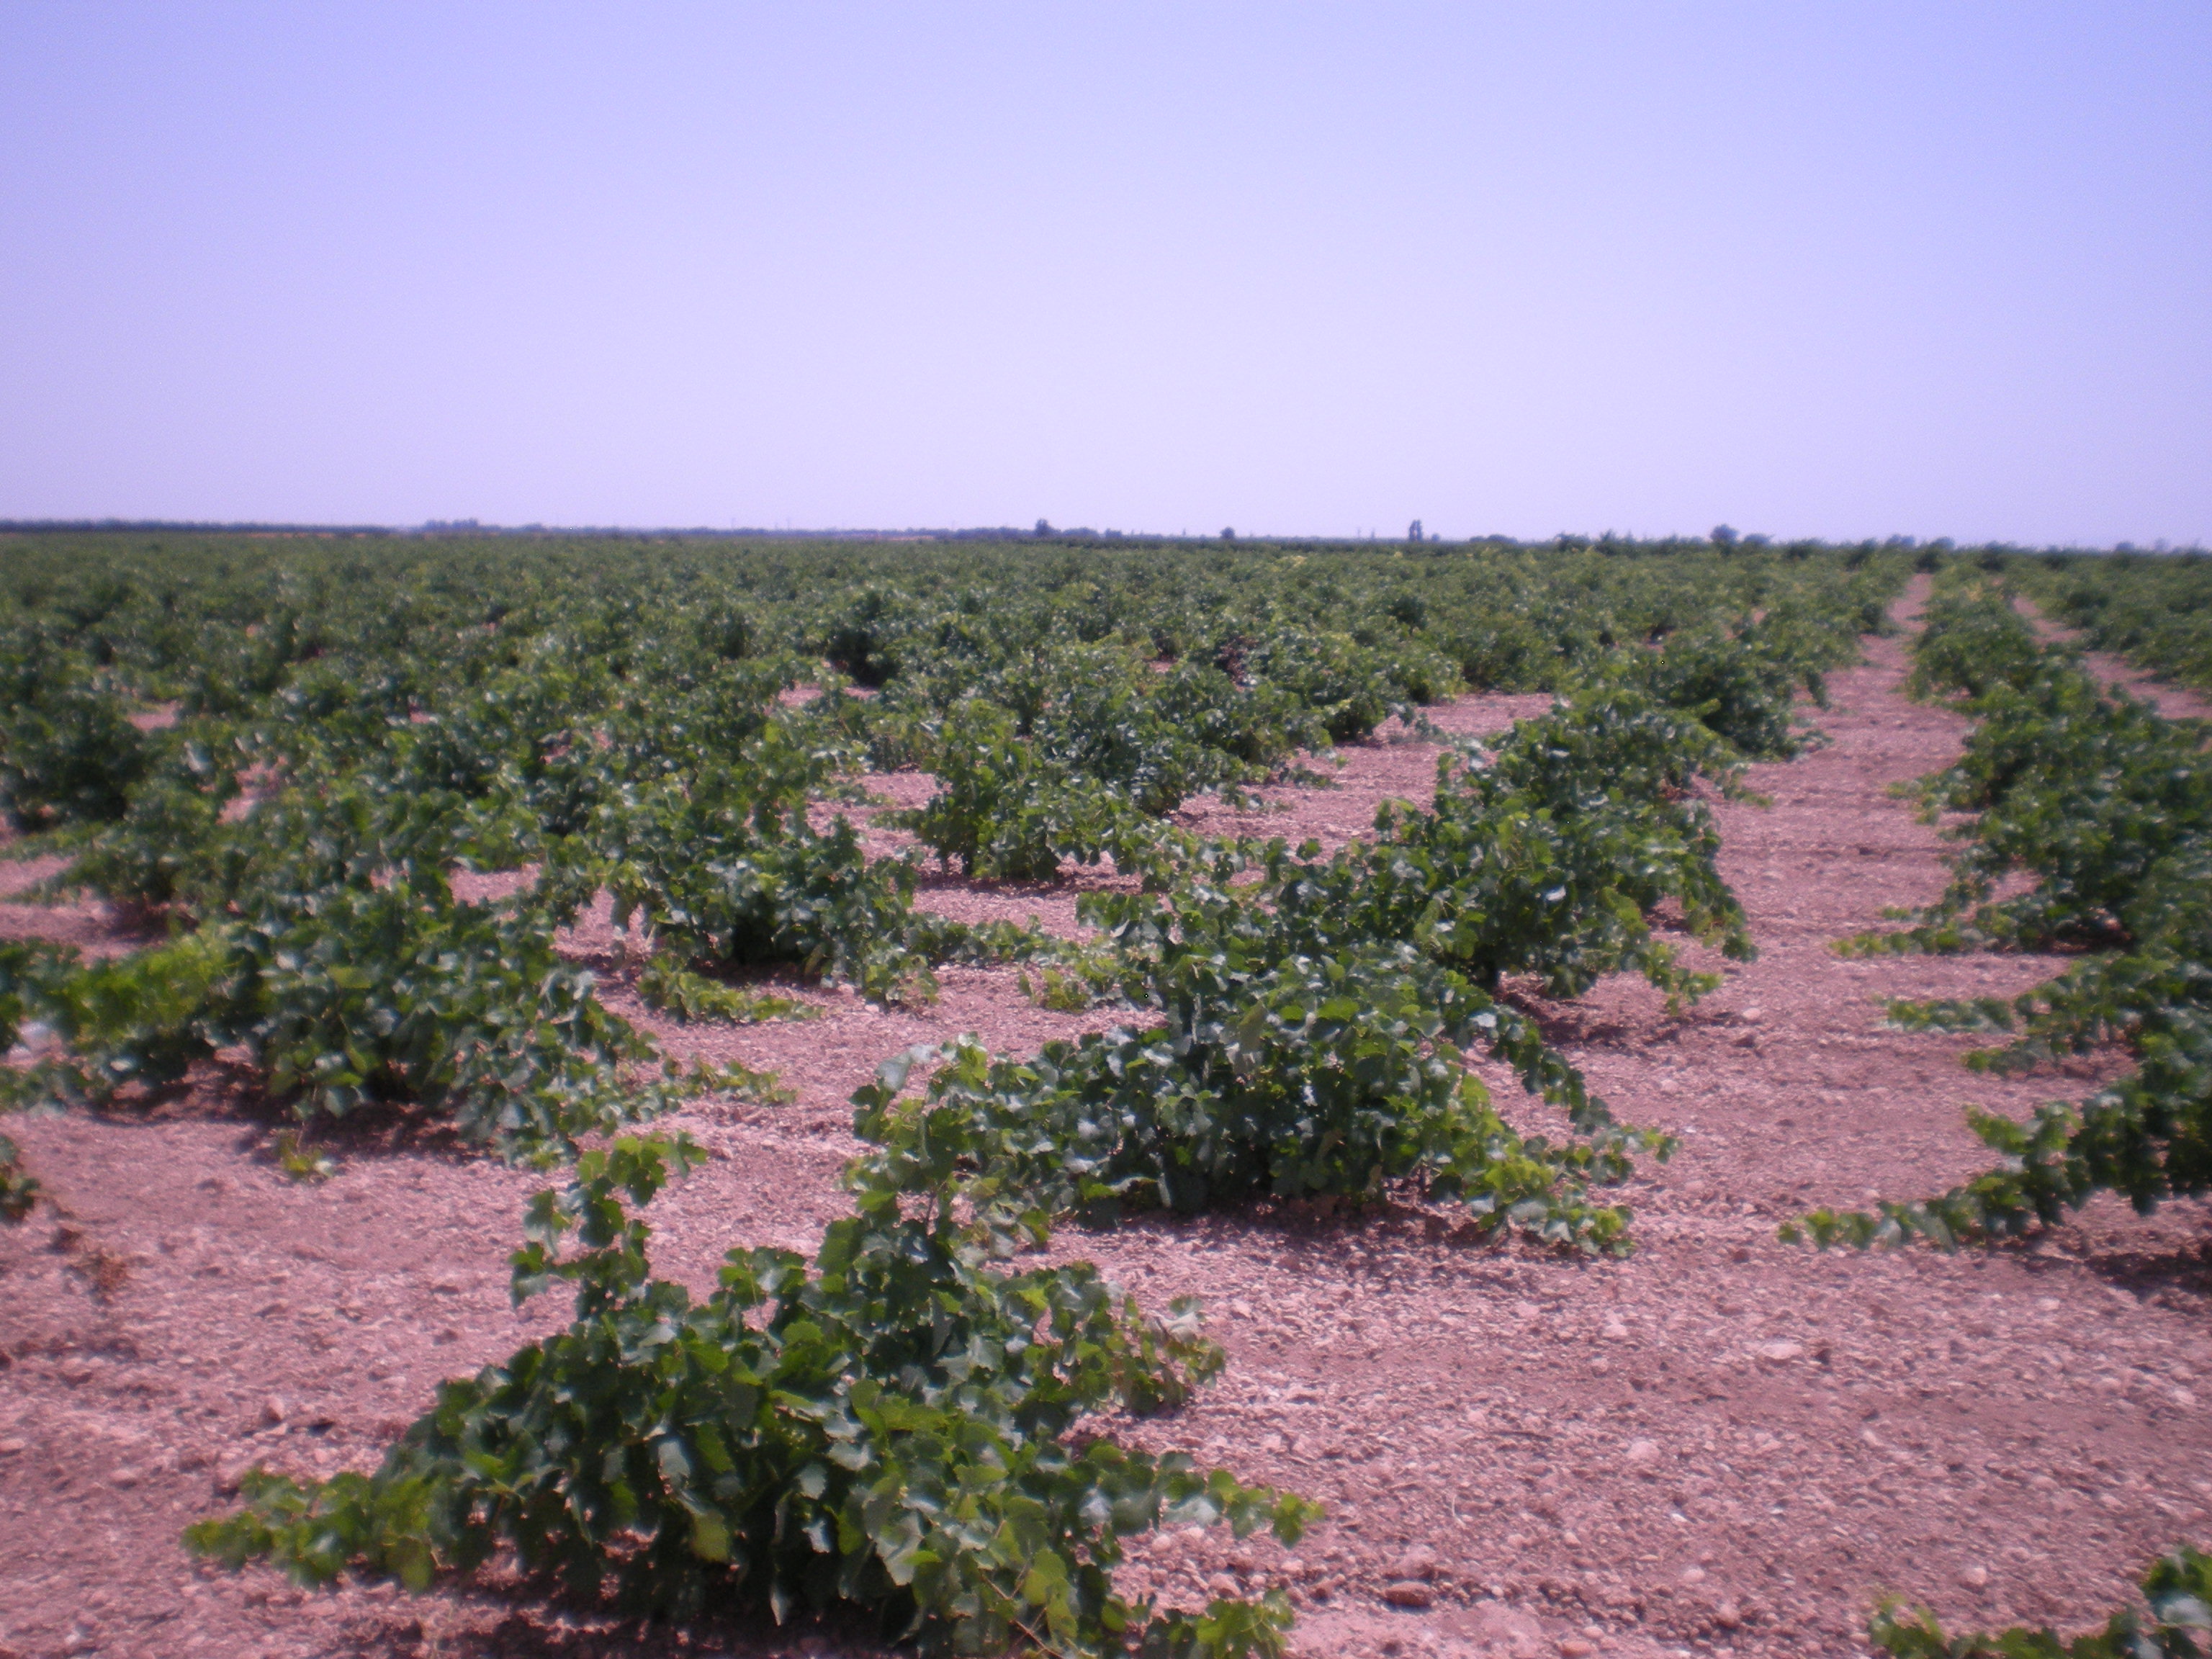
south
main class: Cropland
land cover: Vineyards
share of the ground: 25 - 50 %
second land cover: Other bare soil
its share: > 75 %
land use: Agriculture (excluding fallow land and kitchen gardens)
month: June
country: ES
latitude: 39.6394
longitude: -3.2469
